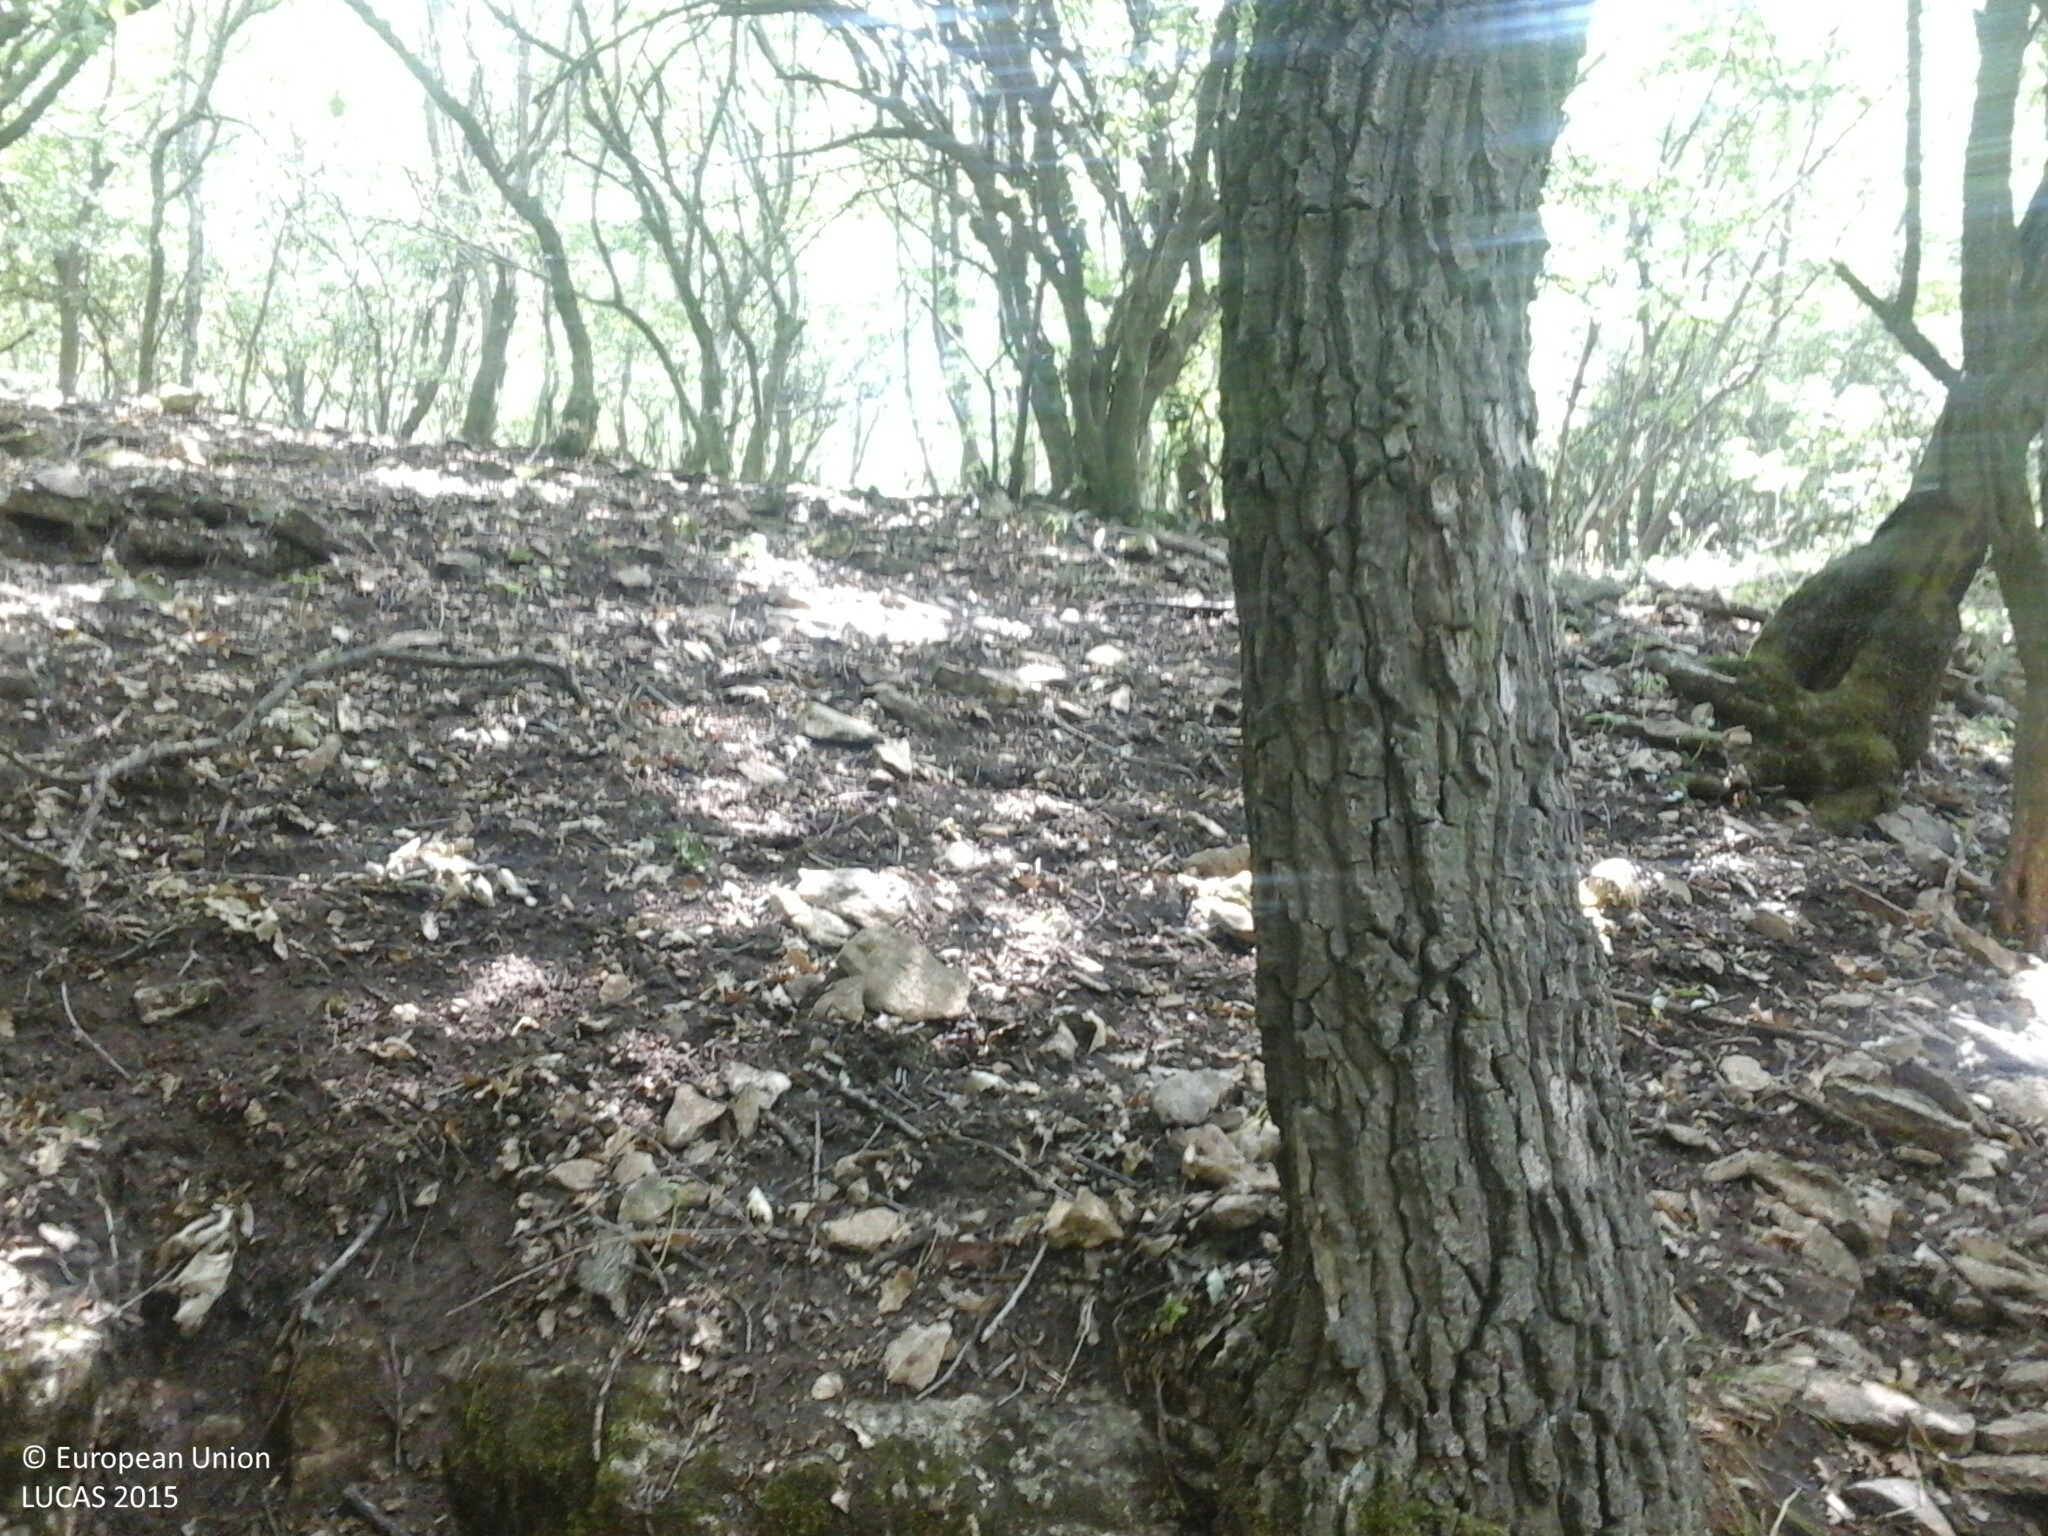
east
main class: Woodland
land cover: Broadleaved woodland
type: acidophilous oak and oak-birch forest
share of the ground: > 75 %
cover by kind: broadleaved forest trees 95 %, herbaceous plants 5 %
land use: Forestry
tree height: > 5 m
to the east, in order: Broadleaved woodland
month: August
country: HU
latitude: 47.4537
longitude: 18.3556
